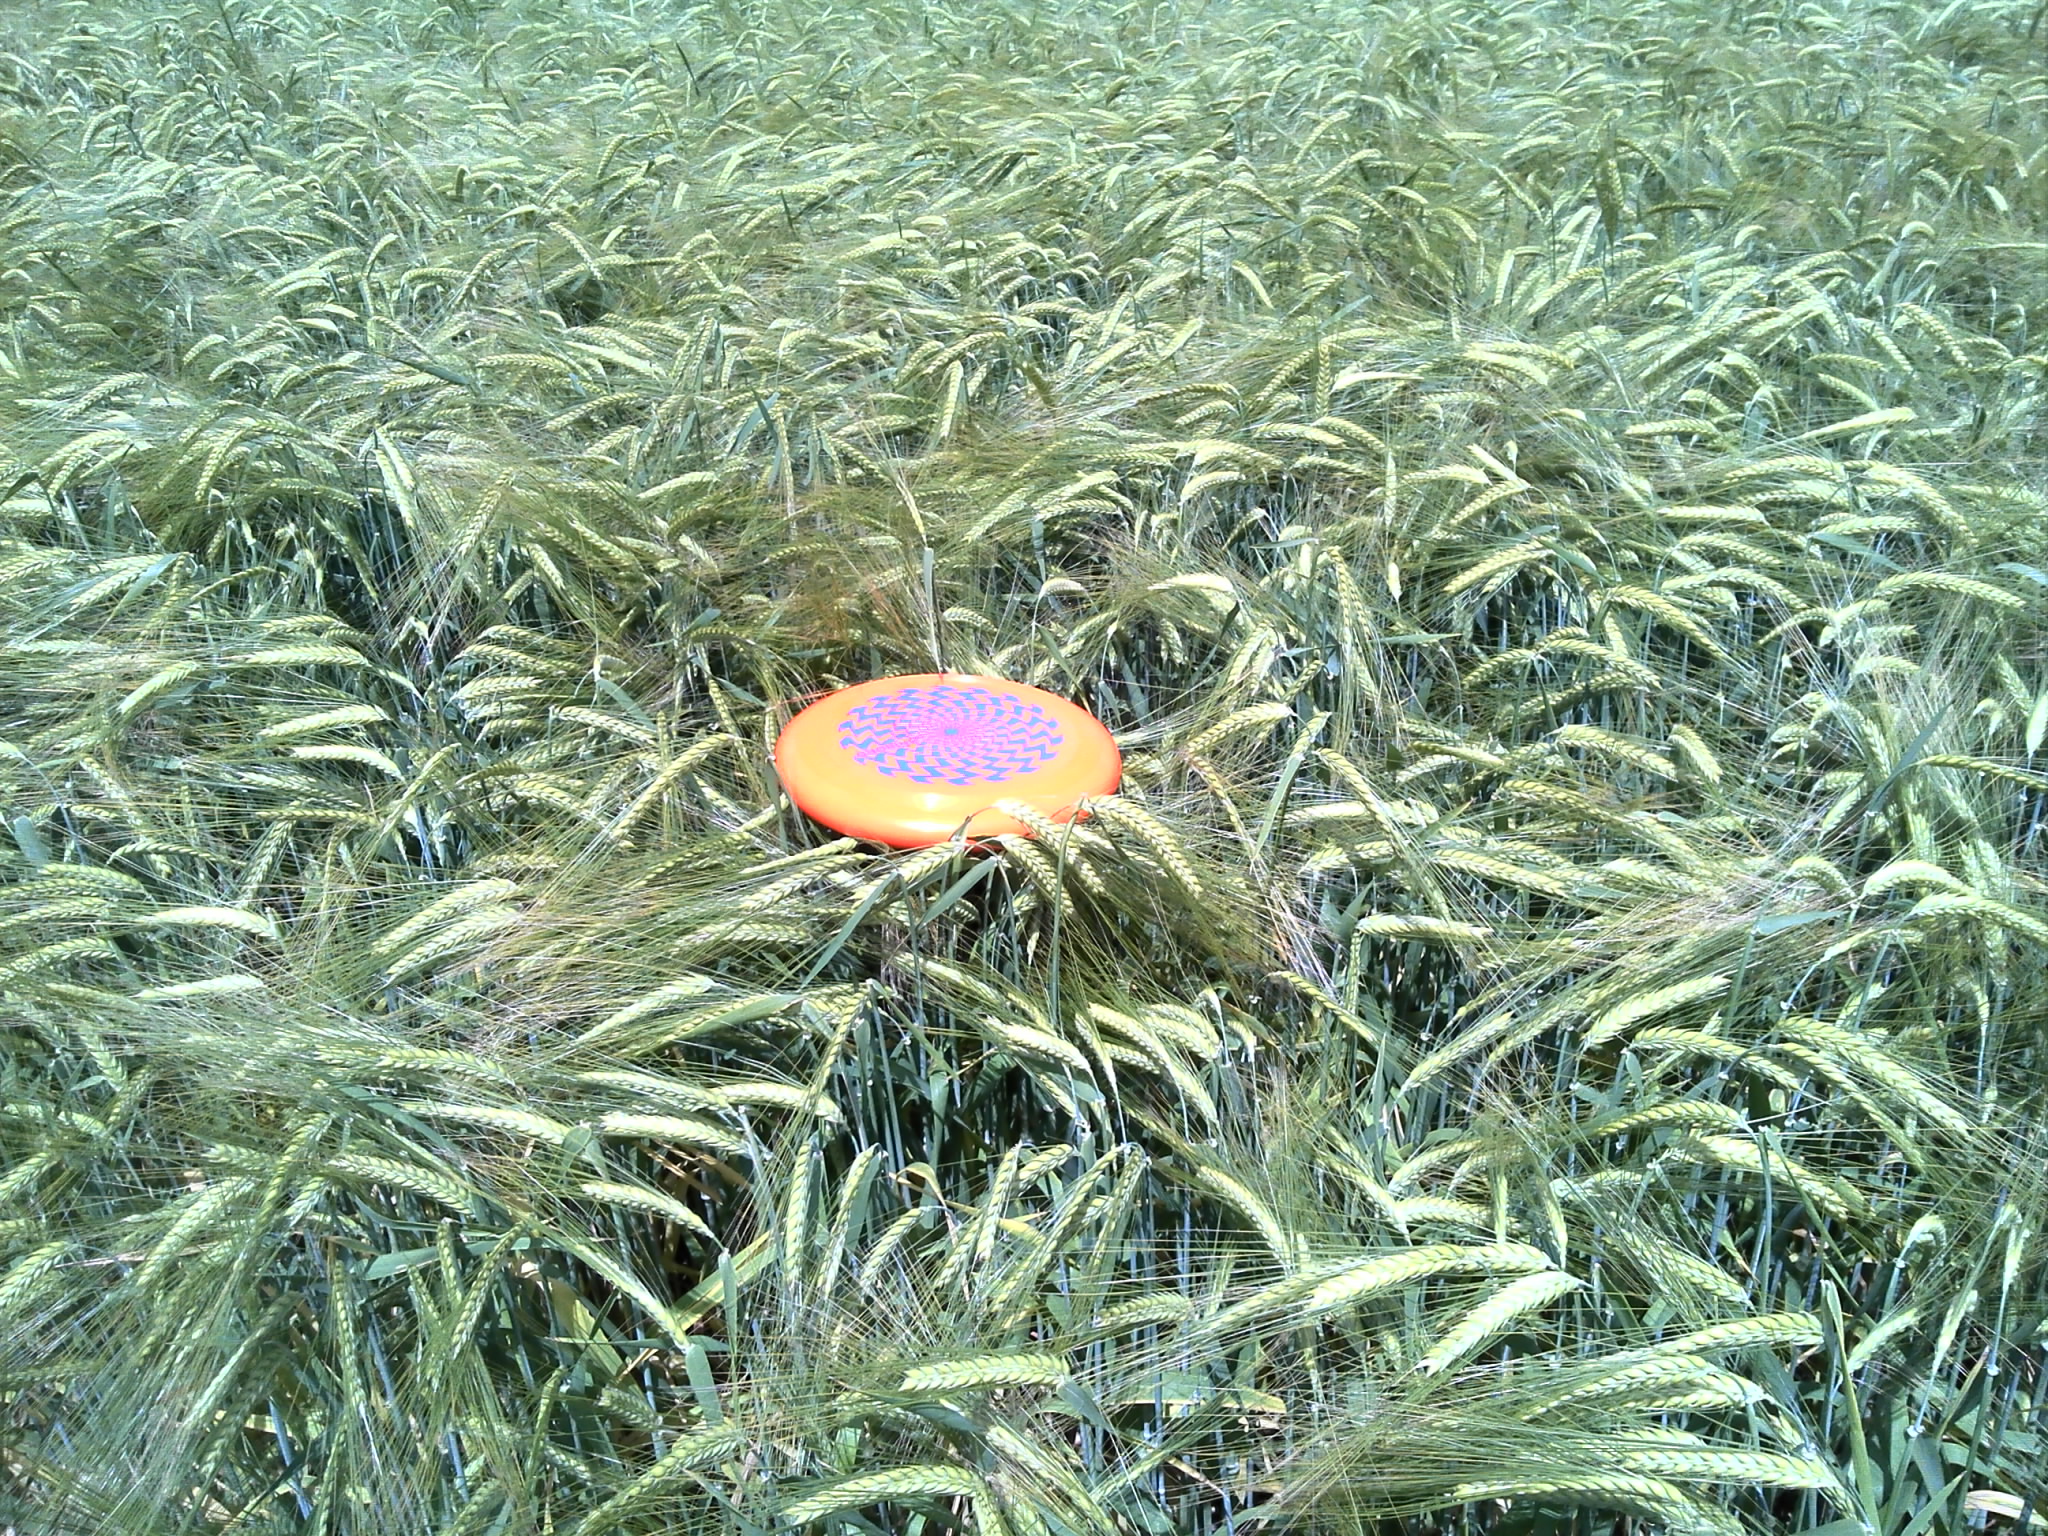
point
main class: Cropland
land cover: Barley
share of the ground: > 75 %
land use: Agriculture (excluding fallow land and kitchen gardens)
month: May
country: FR
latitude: 46.5815
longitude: 1.5990
